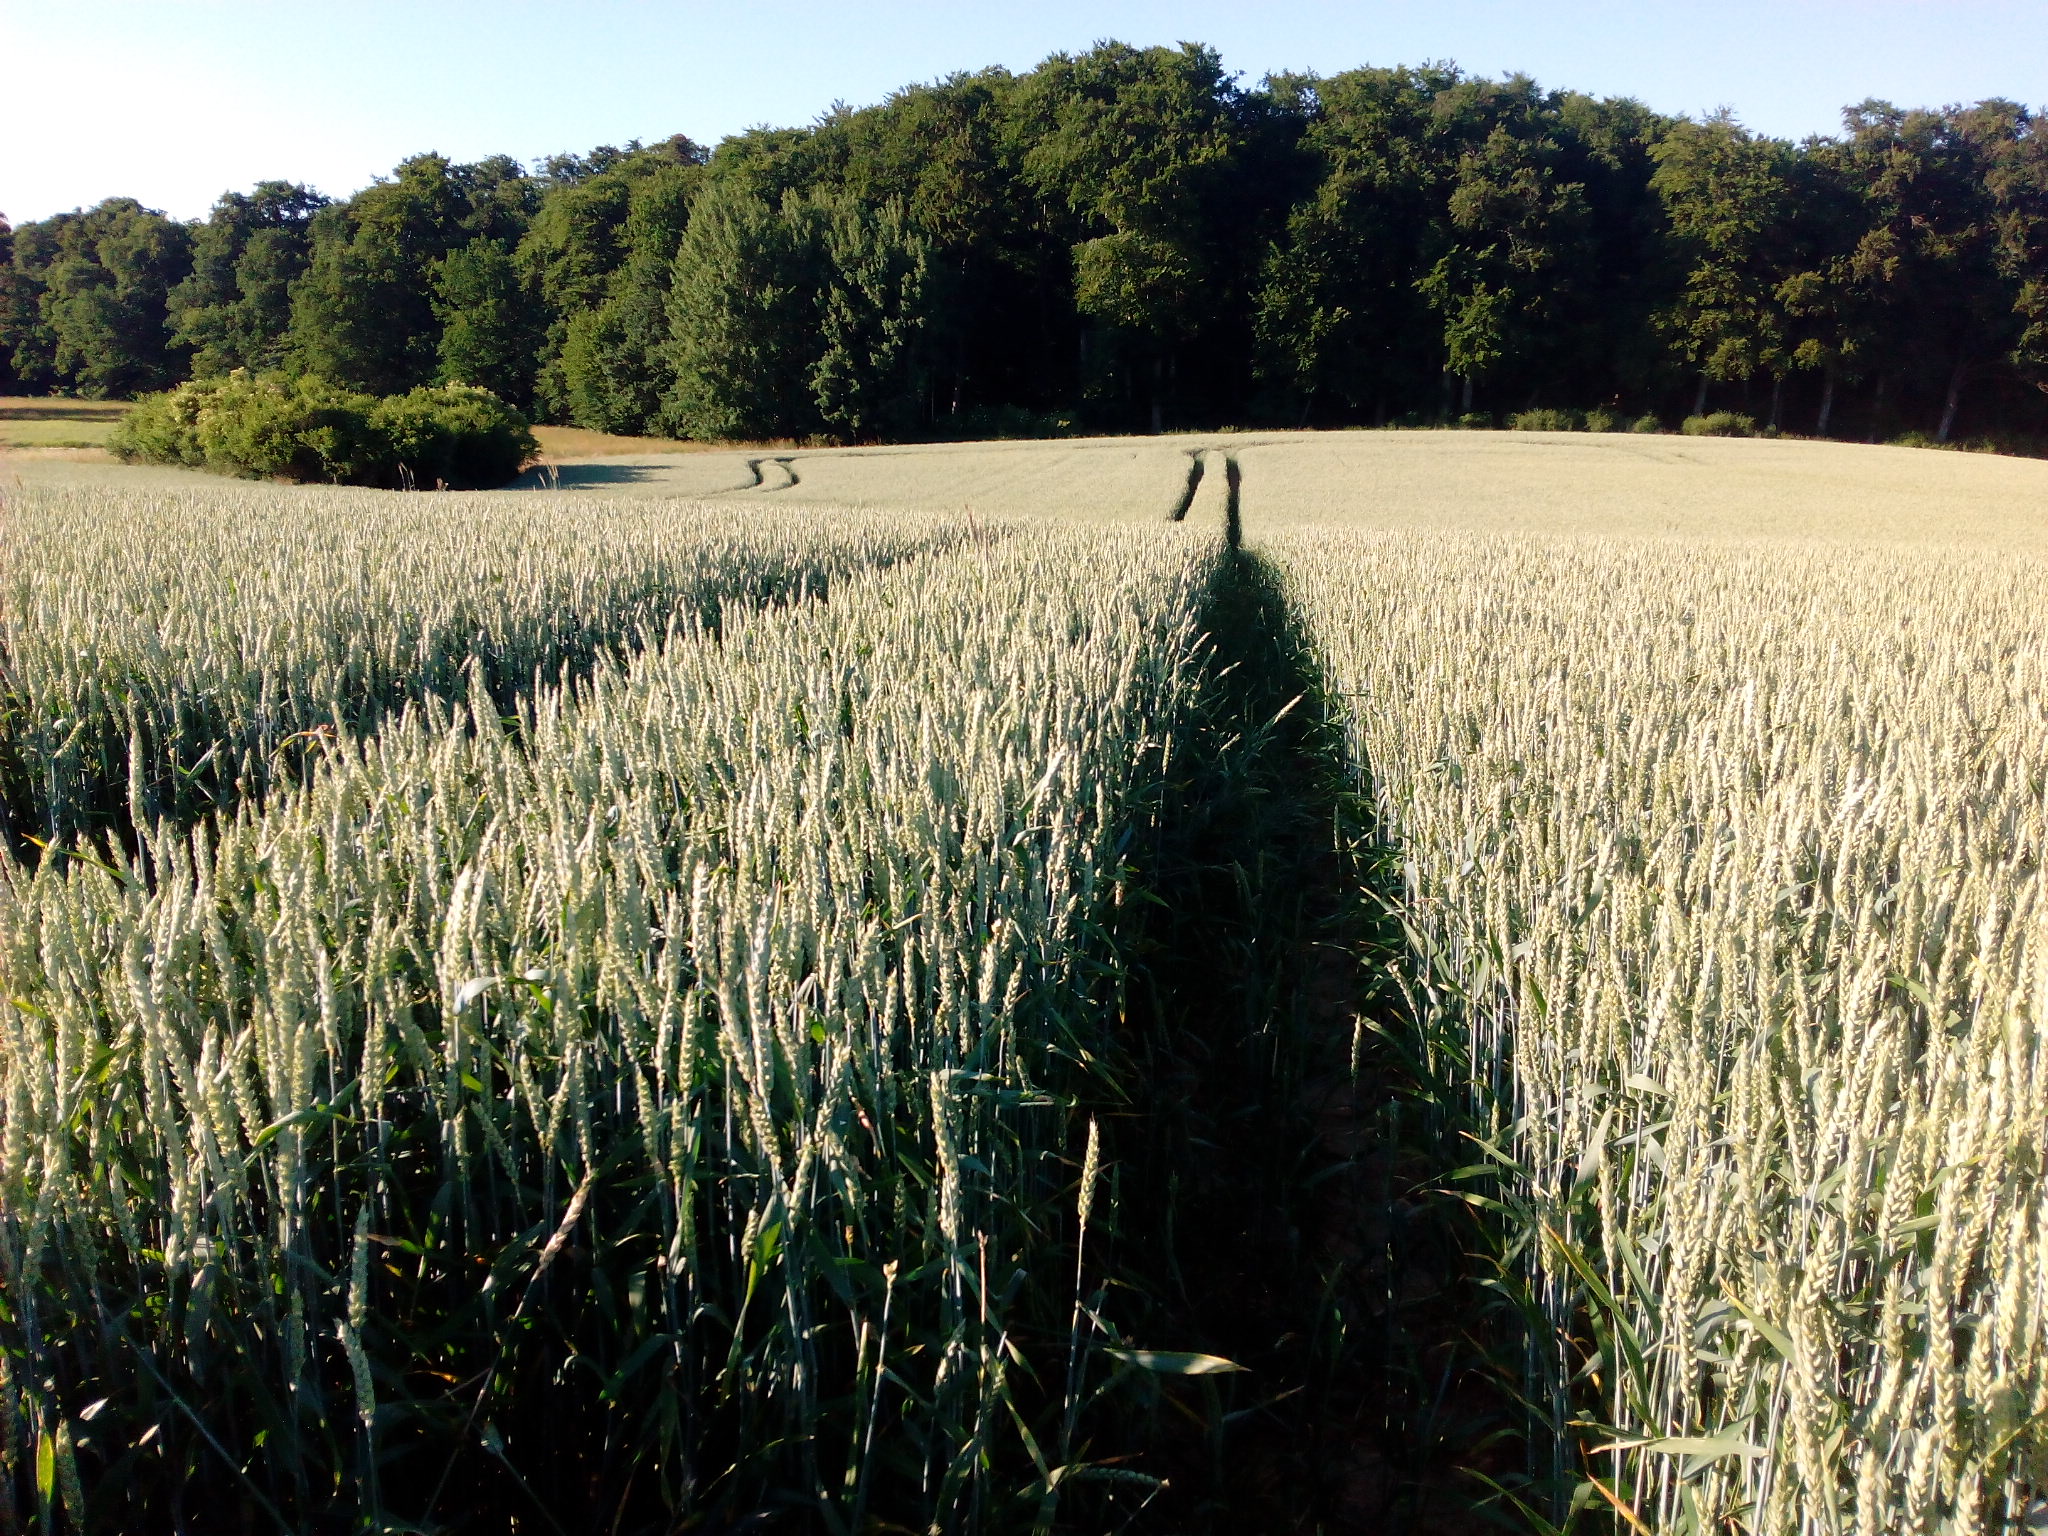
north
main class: Cropland
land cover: Common wheat
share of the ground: > 75 %
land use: Agriculture (excluding fallow land and kitchen gardens)
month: July
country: DE
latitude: 53.4315
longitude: 13.2055
